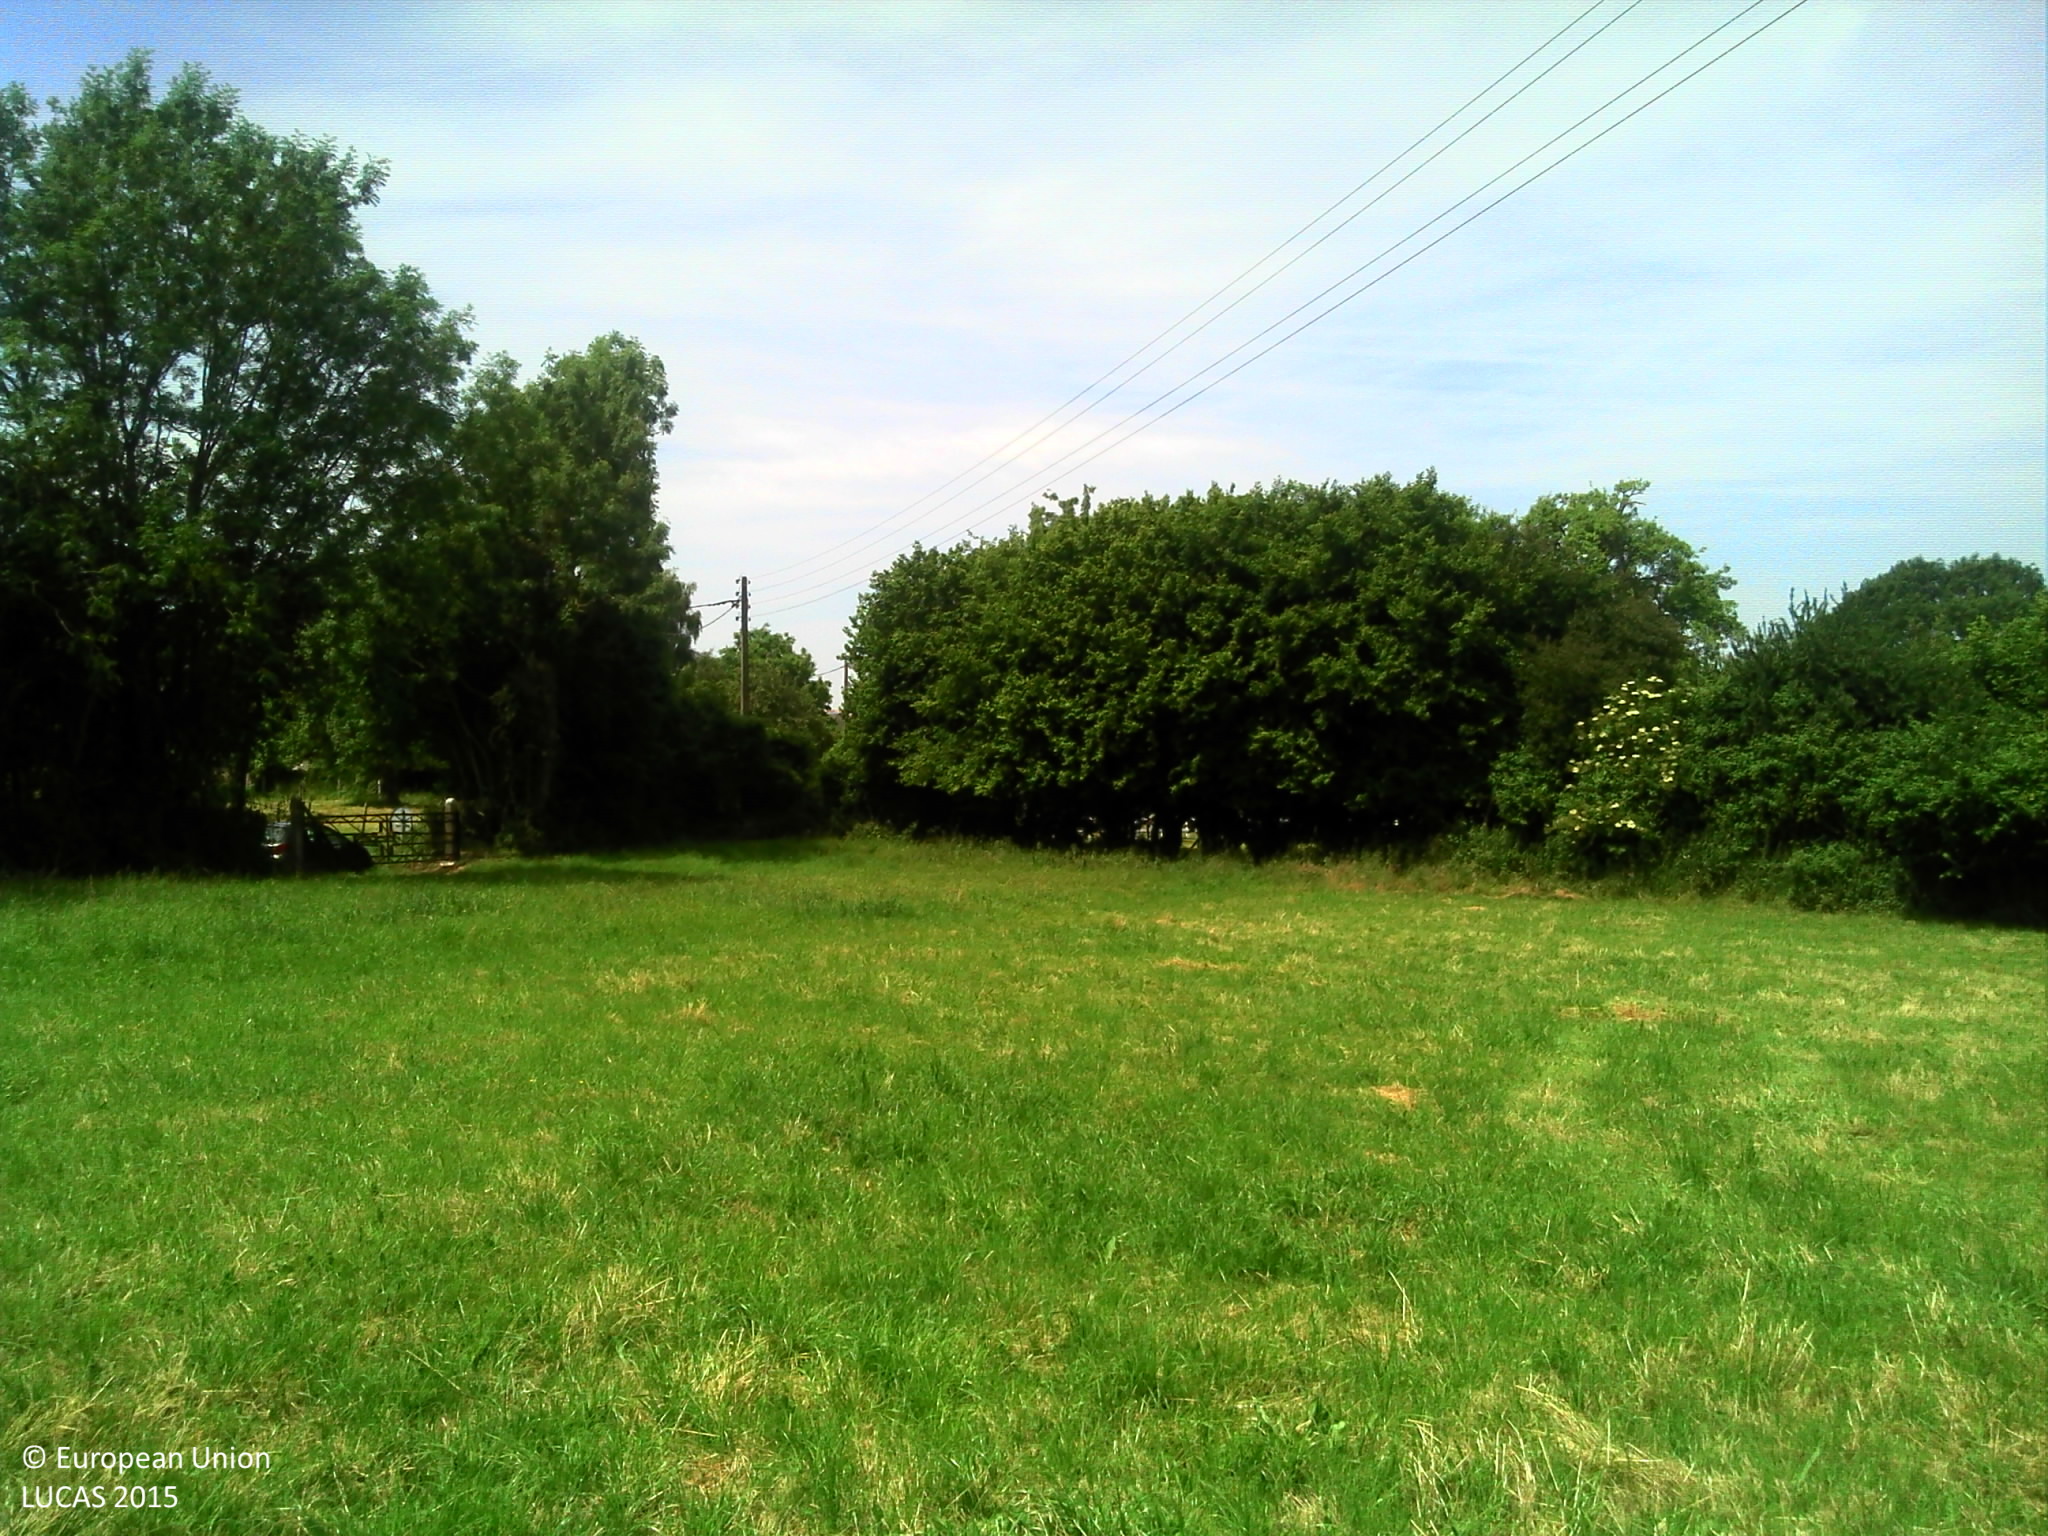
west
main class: Grassland
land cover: Grassland without tree/shrub cover
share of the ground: > 75 %
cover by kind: herbaceous plants 100 %
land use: Agriculture (excluding fallow land and kitchen gardens)
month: June
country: FR
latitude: 48.7958
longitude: -0.2564
